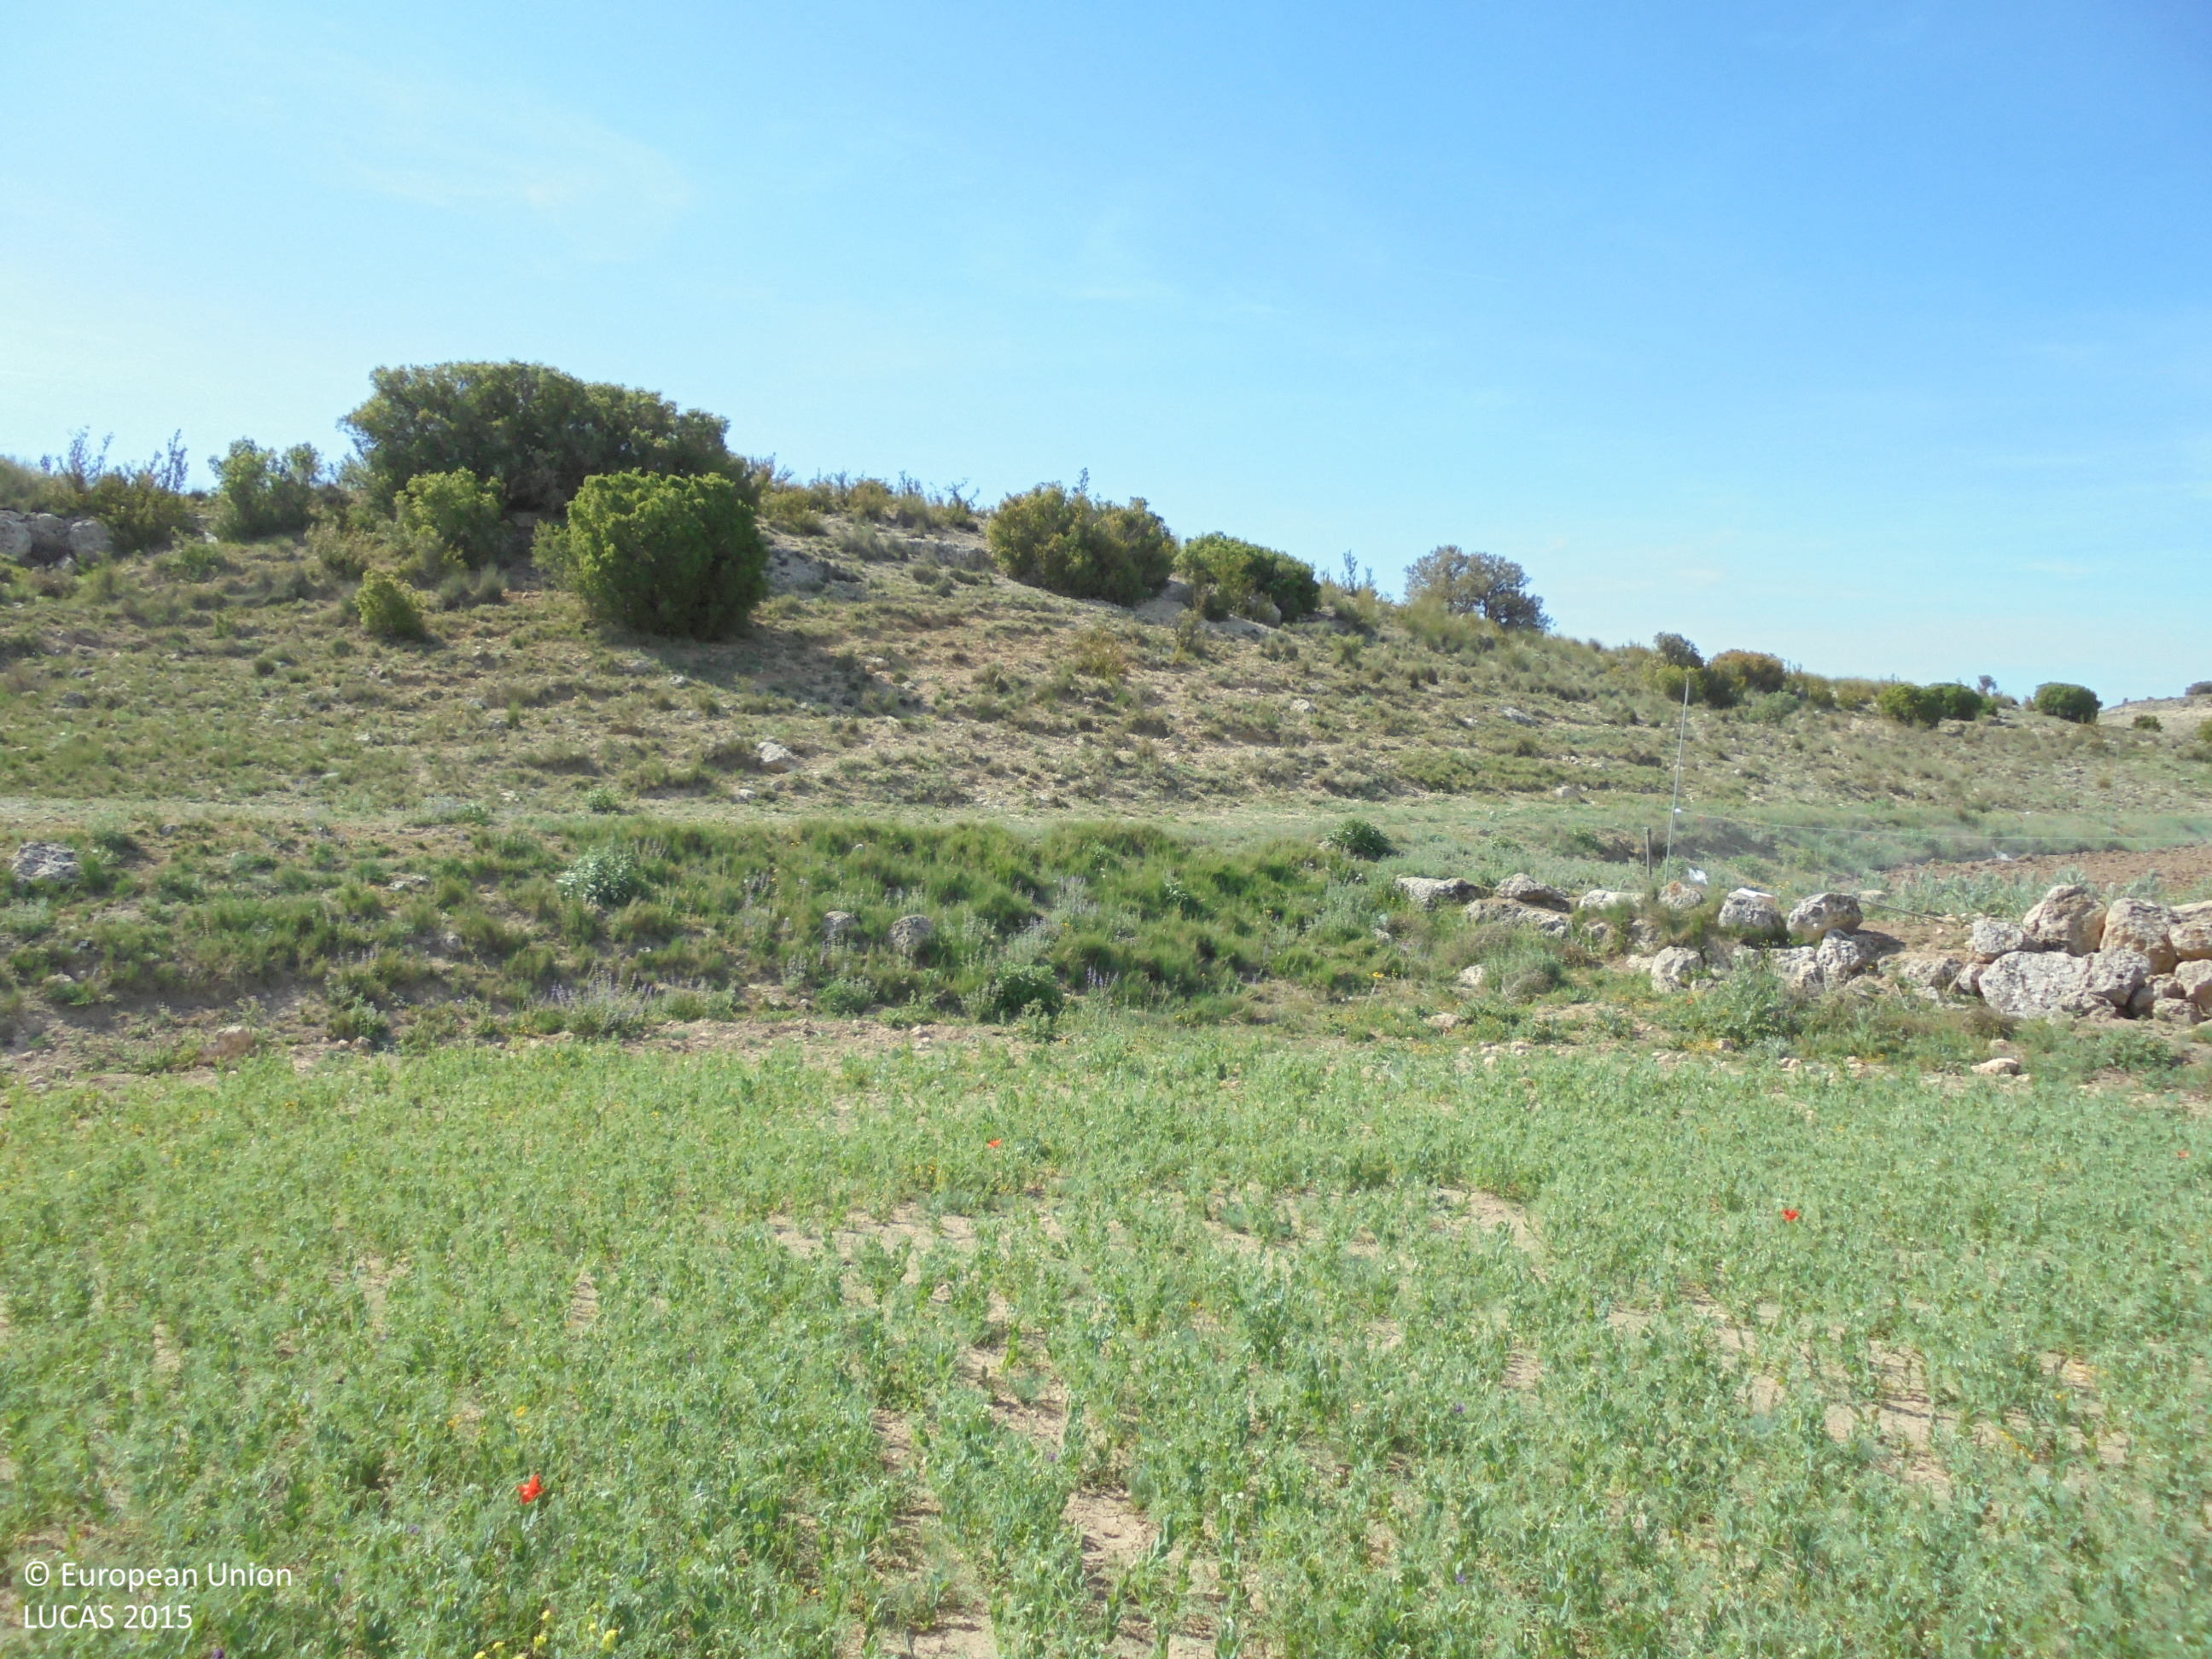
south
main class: Cropland
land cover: Dry pulses
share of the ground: 50 - 75 %
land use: Agriculture (excluding fallow land and kitchen gardens)
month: May
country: ES
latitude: 39.1461
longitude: -1.5359
